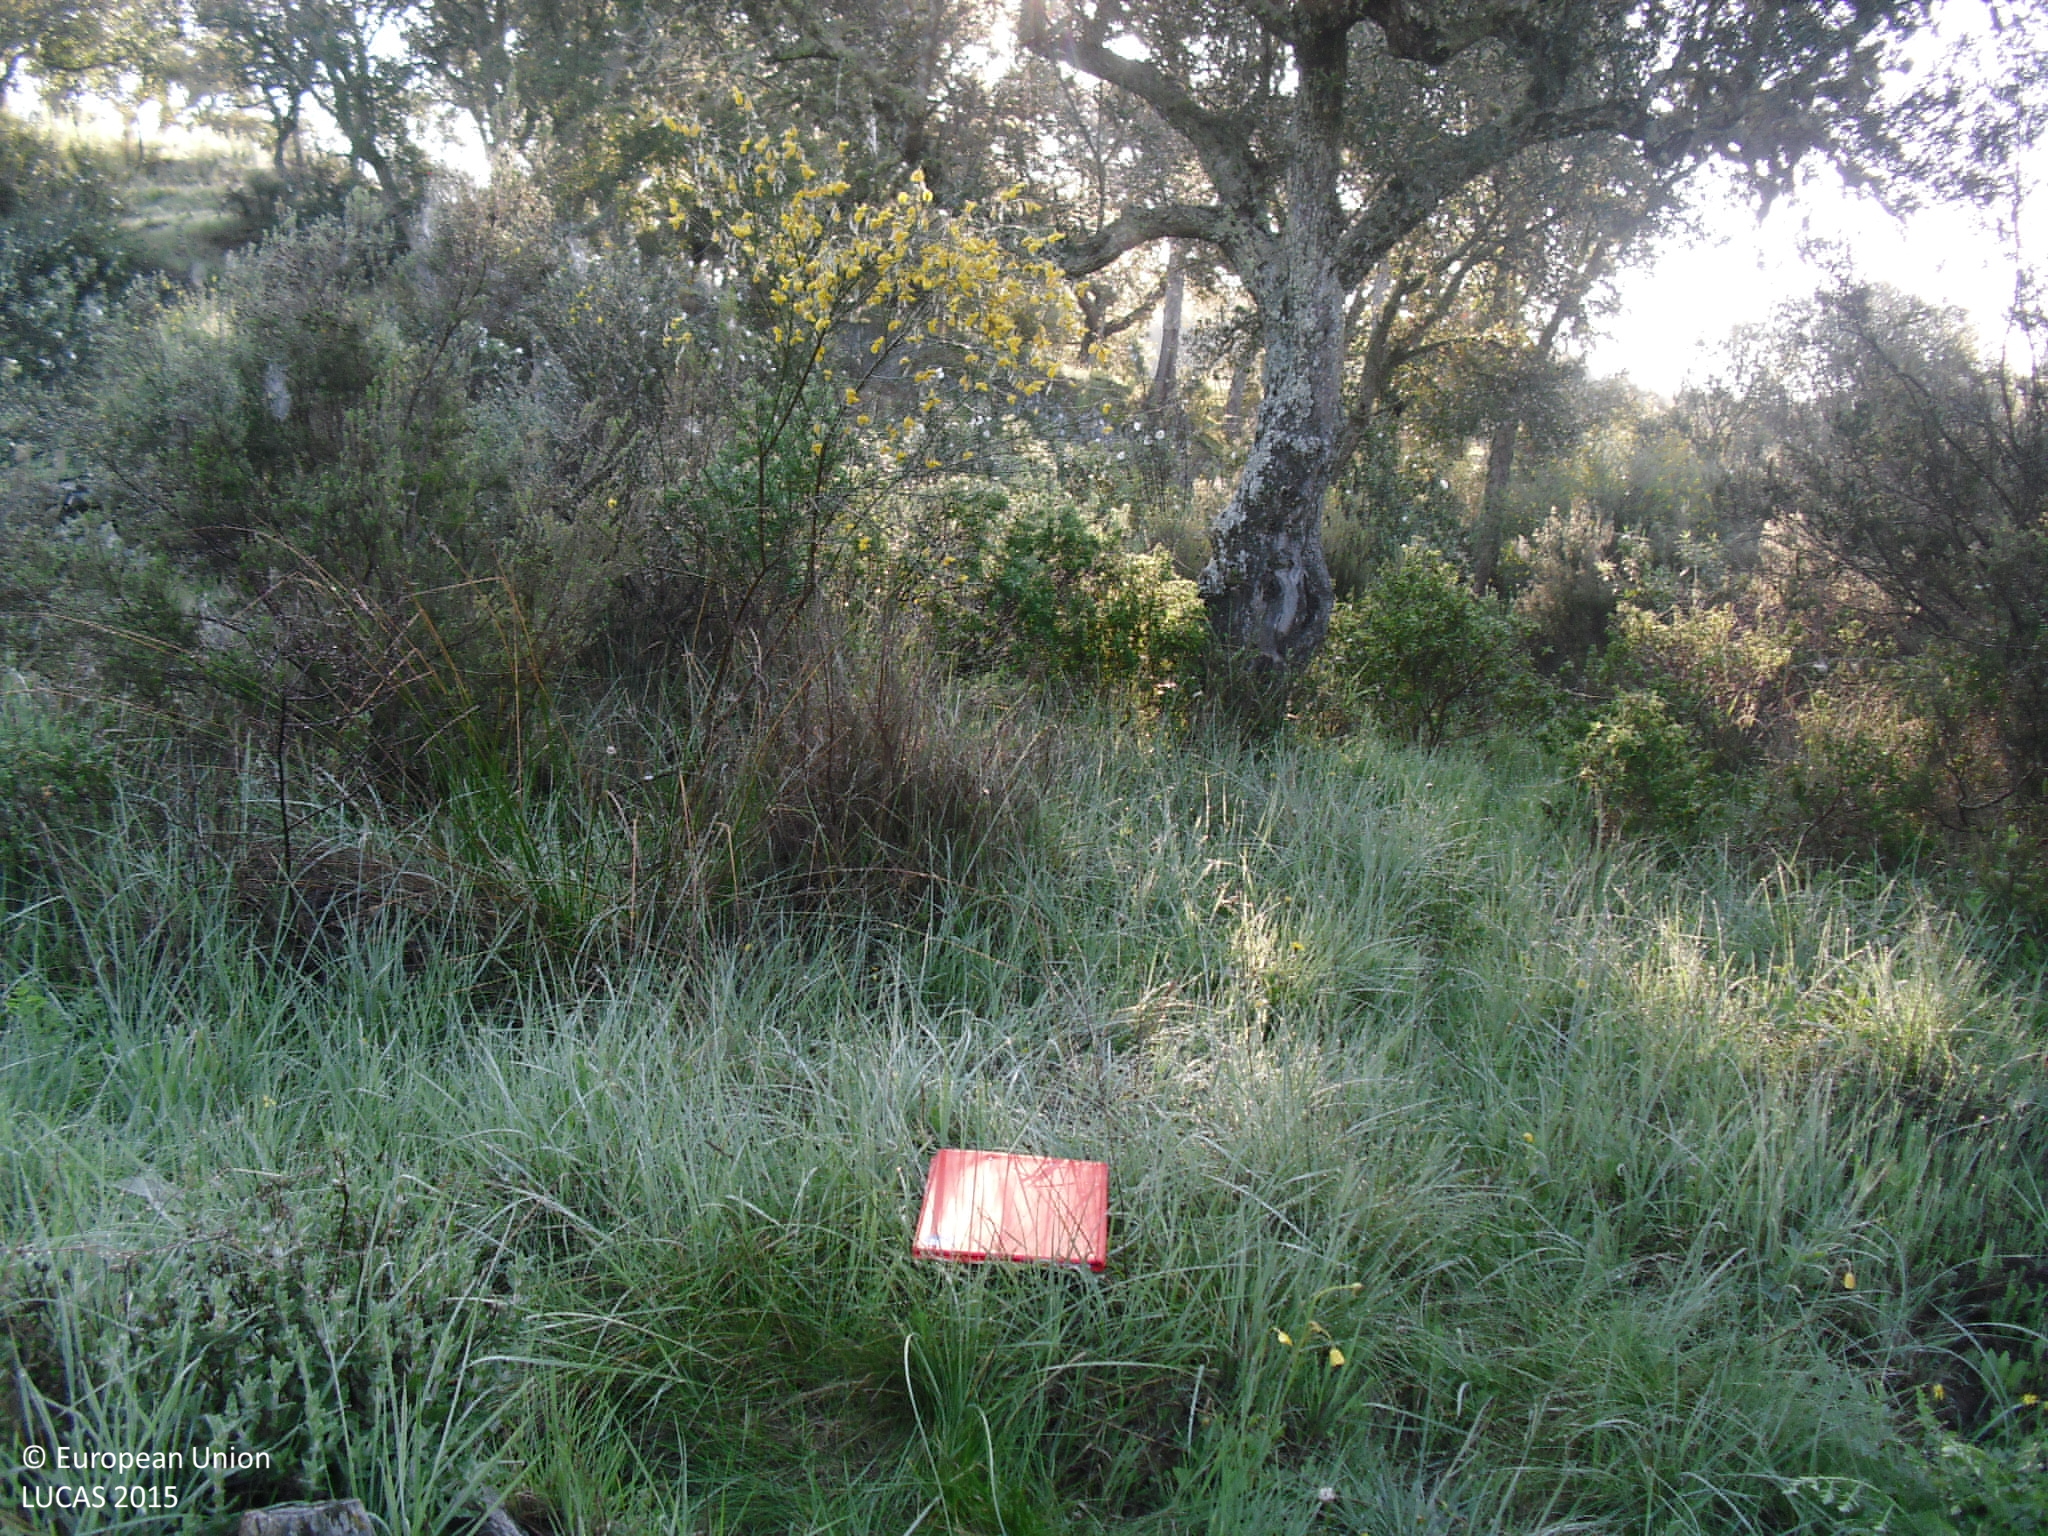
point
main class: Woodland
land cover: Broadleaved woodland
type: broadleaved evergreen forest
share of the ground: 25 - 50 %
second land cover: Grassland without tree/shrub cover
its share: > 75 %
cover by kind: herbaceous plants 60 %, broadleaved forest trees 30 %, shrubs 10 %
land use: Forestry
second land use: Agriculture (excluding fallow land and kitchen gardens)
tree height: > 5 m
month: April
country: ES
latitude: 39.6418
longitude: -7.4931
